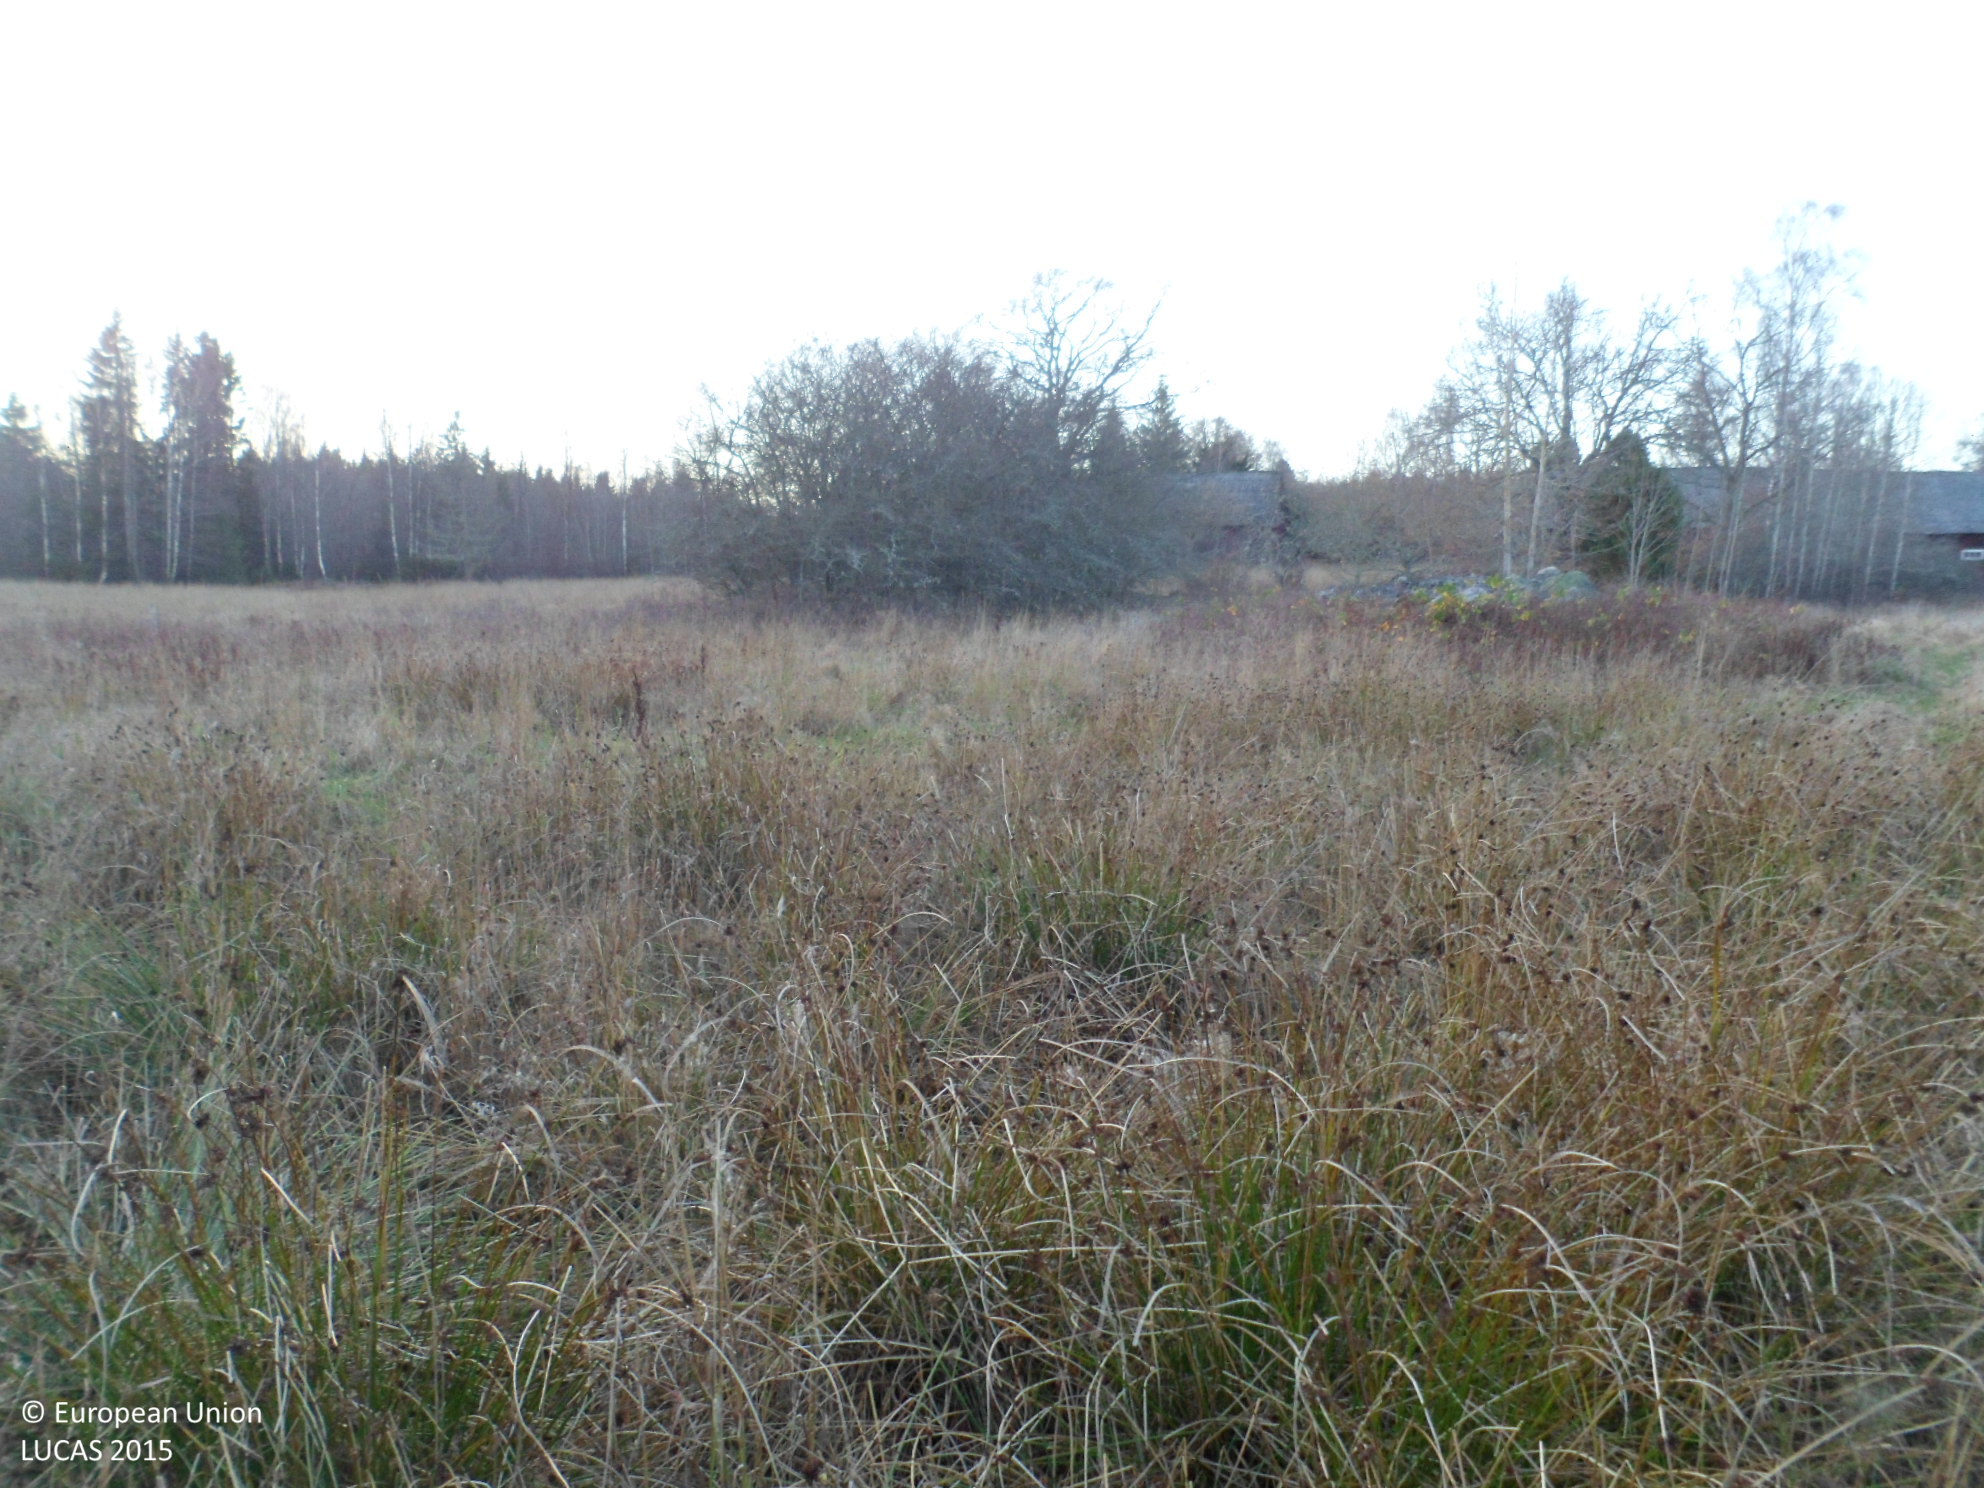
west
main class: Grassland
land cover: Grassland with sparse tree/shrub cover
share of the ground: > 75 %
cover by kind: herbaceous plants 90 %, broadleaved forest trees 5 %, shrubs 5 %
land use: Agriculture (excluding fallow land and kitchen gardens)
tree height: < 5 m
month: November
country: SE
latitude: 56.8162
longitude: 16.1431
